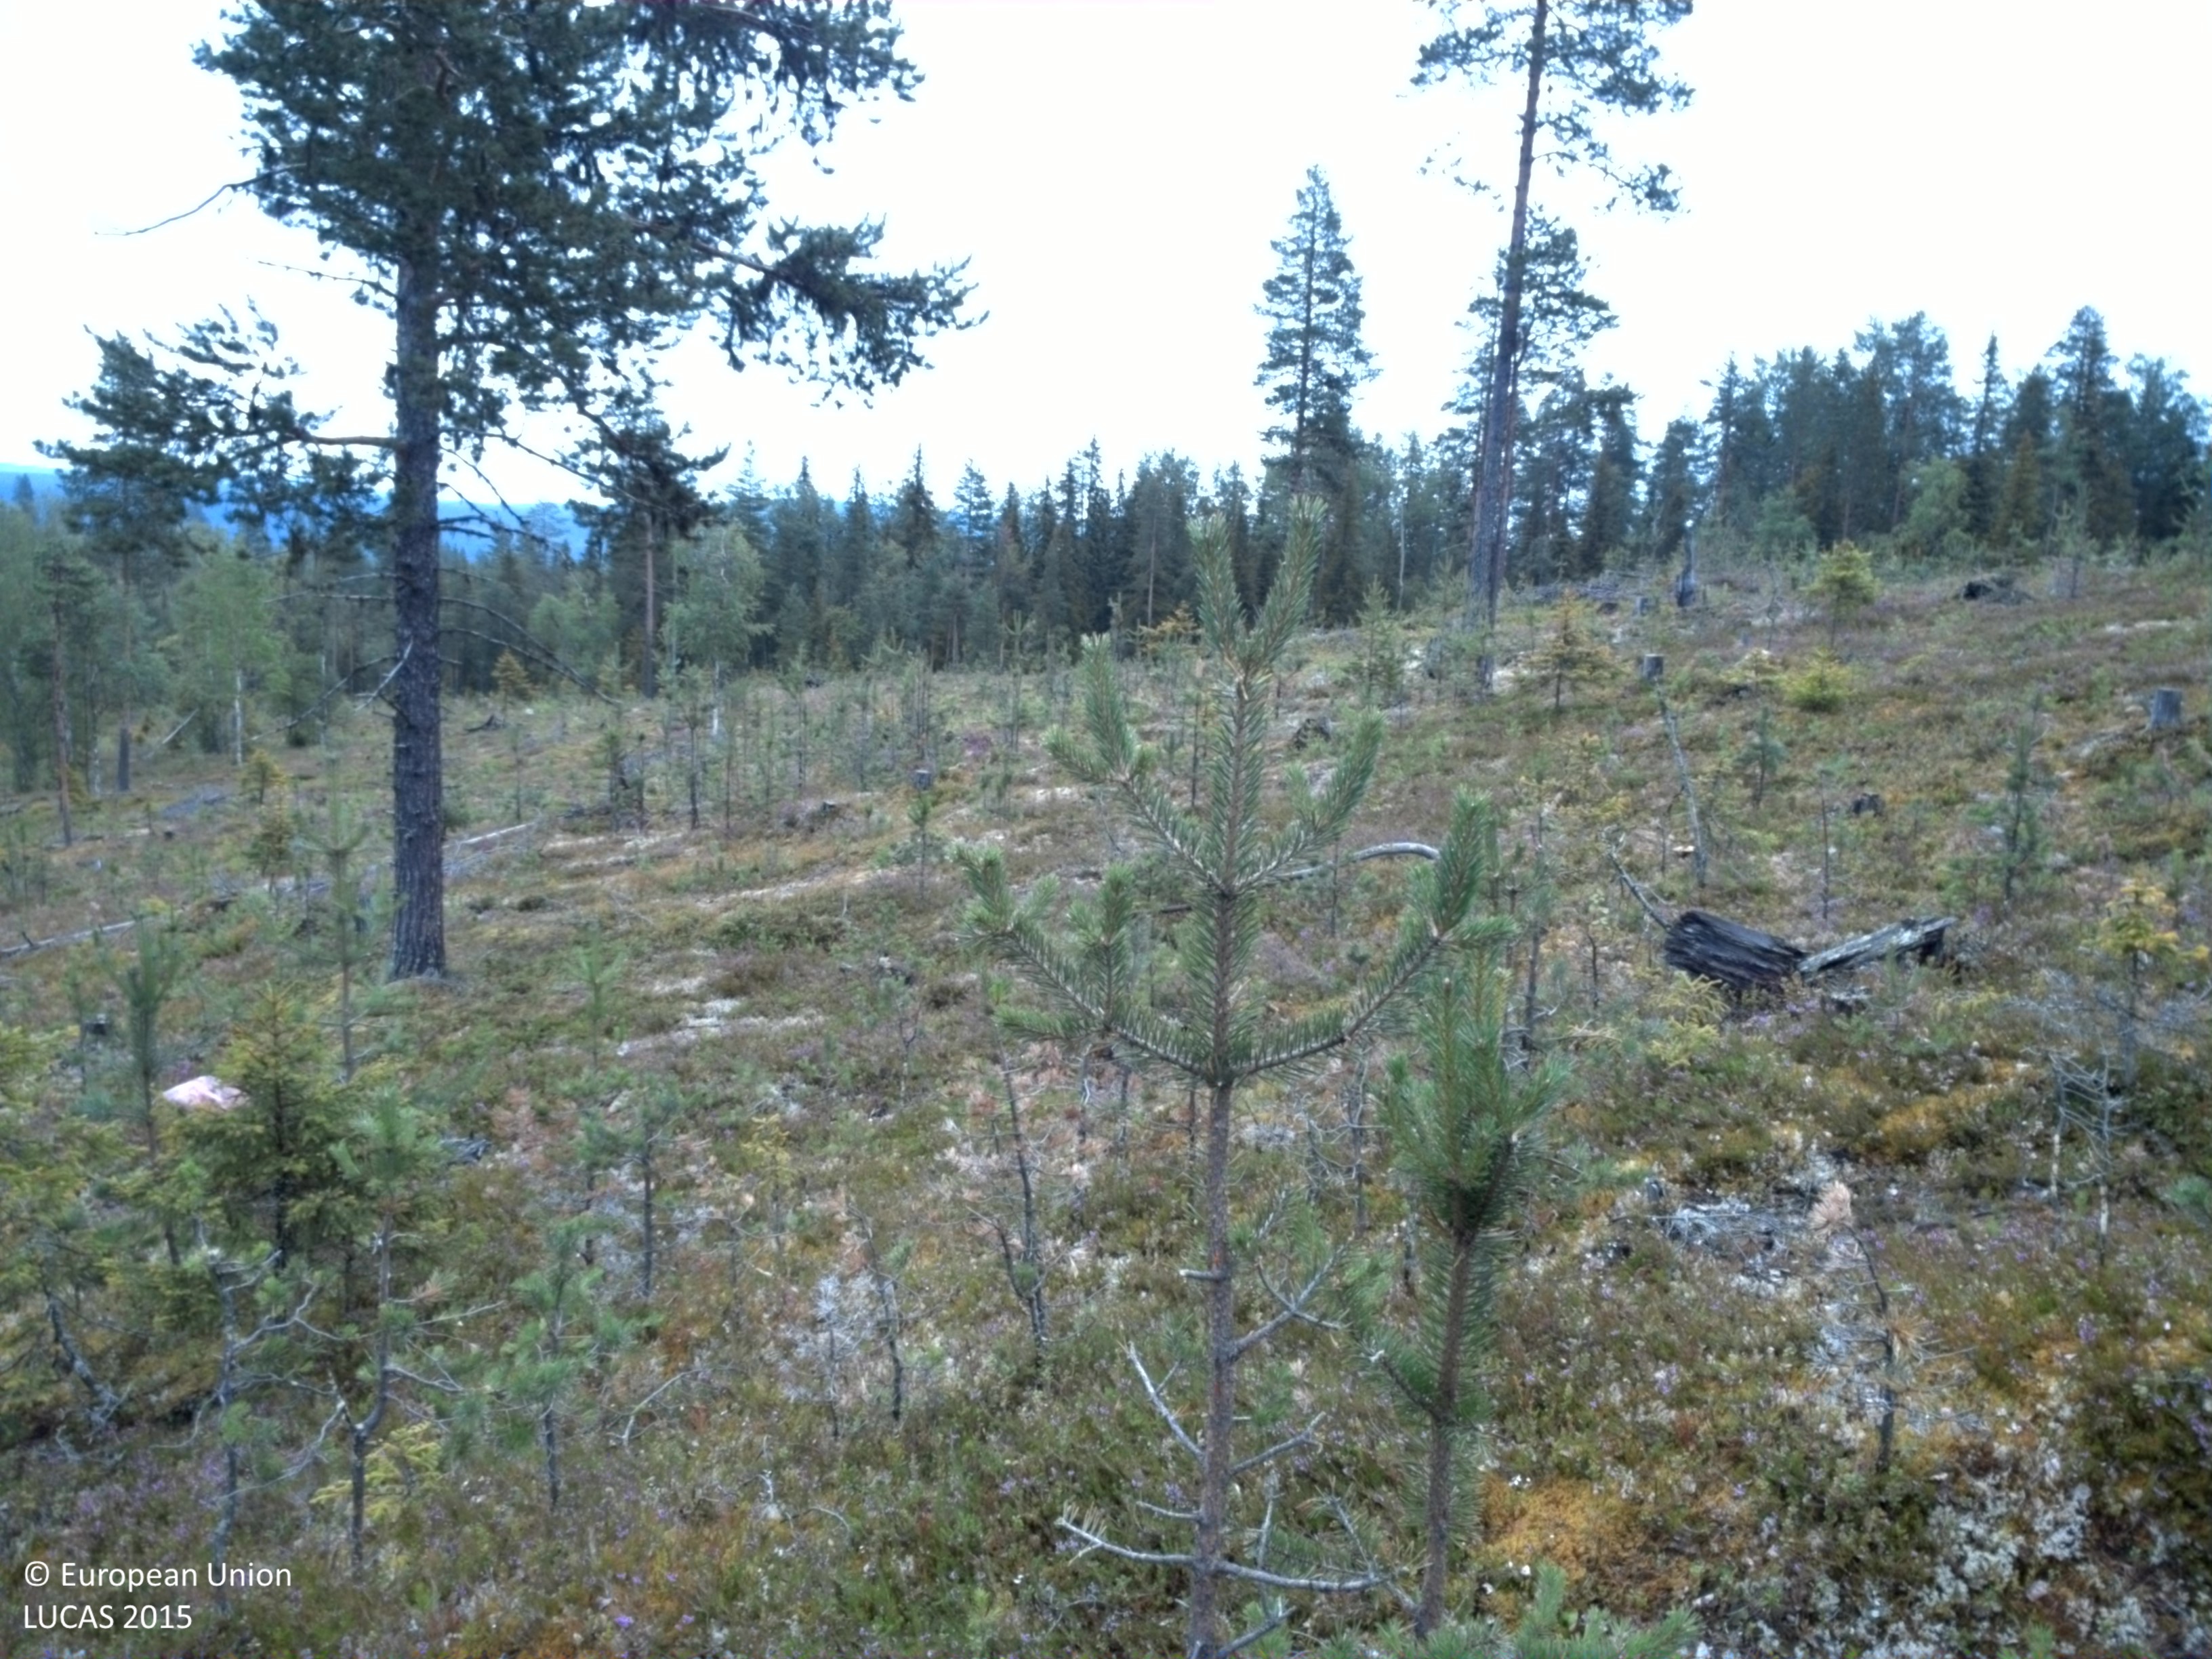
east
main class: Woodland
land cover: Pine dominated coniferous woodland
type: boreal forest
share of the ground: 10 - 25 %
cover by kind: shrubs 80 %, coniferous forest trees 10 %, lichens and mosses 10 %
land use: Forestry
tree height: < 5 m
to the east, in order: Pine dominated coniferous woodland; Shrubland with sparse tree cover; Other coniferous woodland; Pine dominated mixed woodland; Pine dominated coniferous woodland; Tracks; Pine dominated coniferous woodland
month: August
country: SE
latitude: 66.4591
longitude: 20.5247
